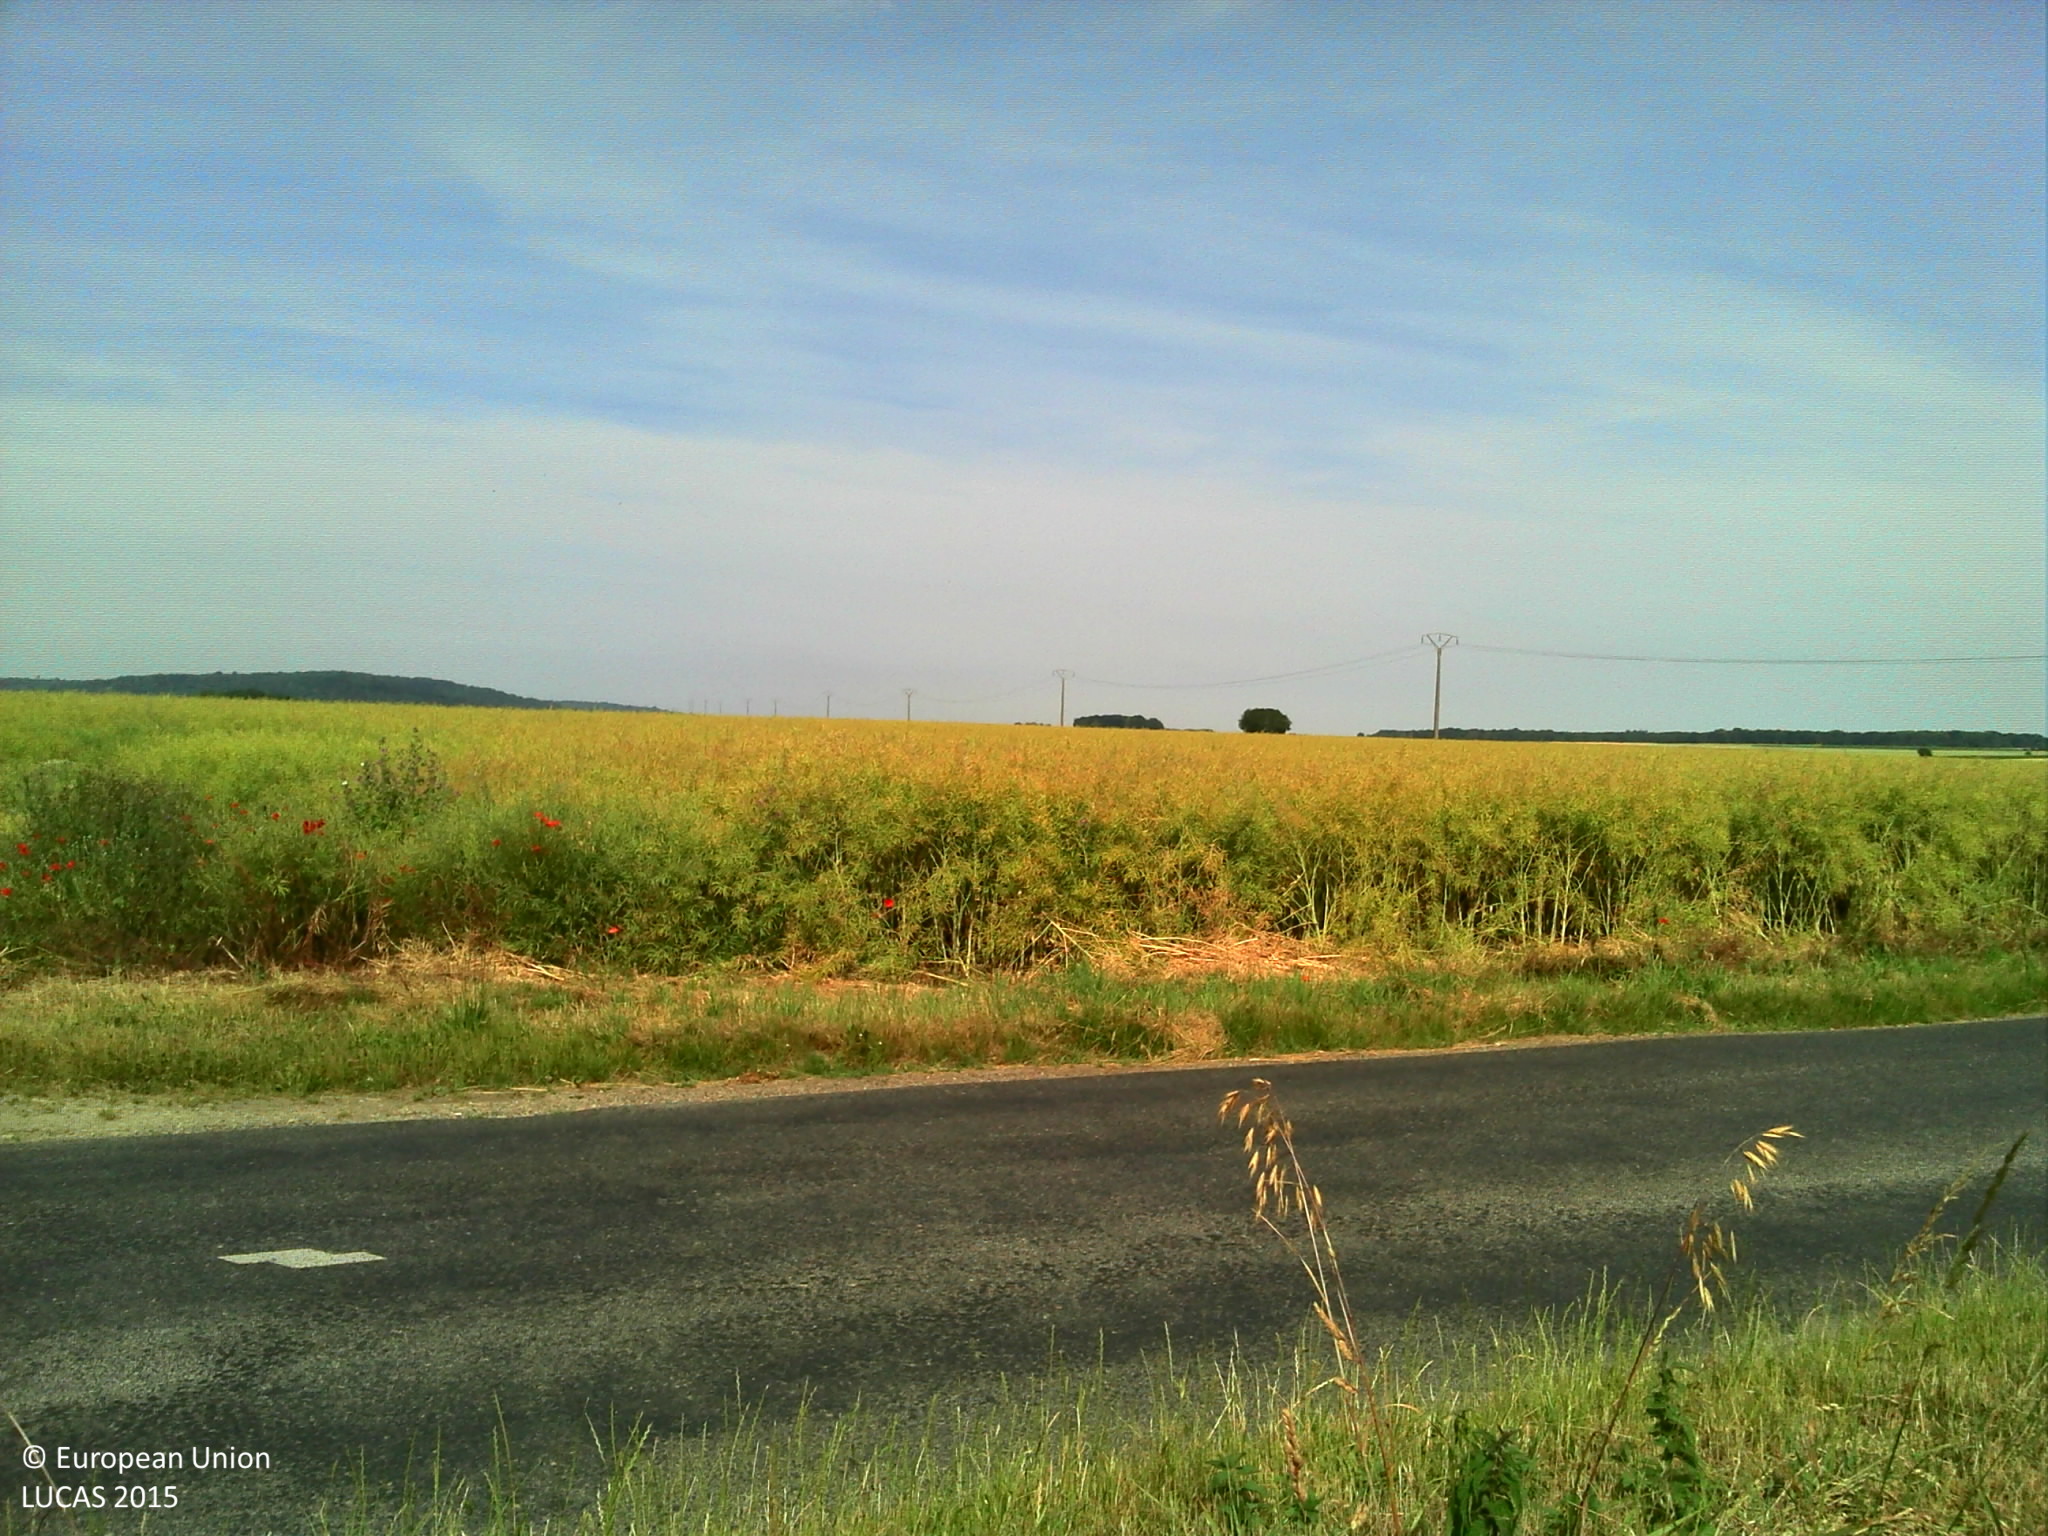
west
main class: Cropland
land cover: Rape and turnip rape
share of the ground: > 75 %
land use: Agriculture (excluding fallow land and kitchen gardens)
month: June
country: FR
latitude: 49.3653
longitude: 2.5941
